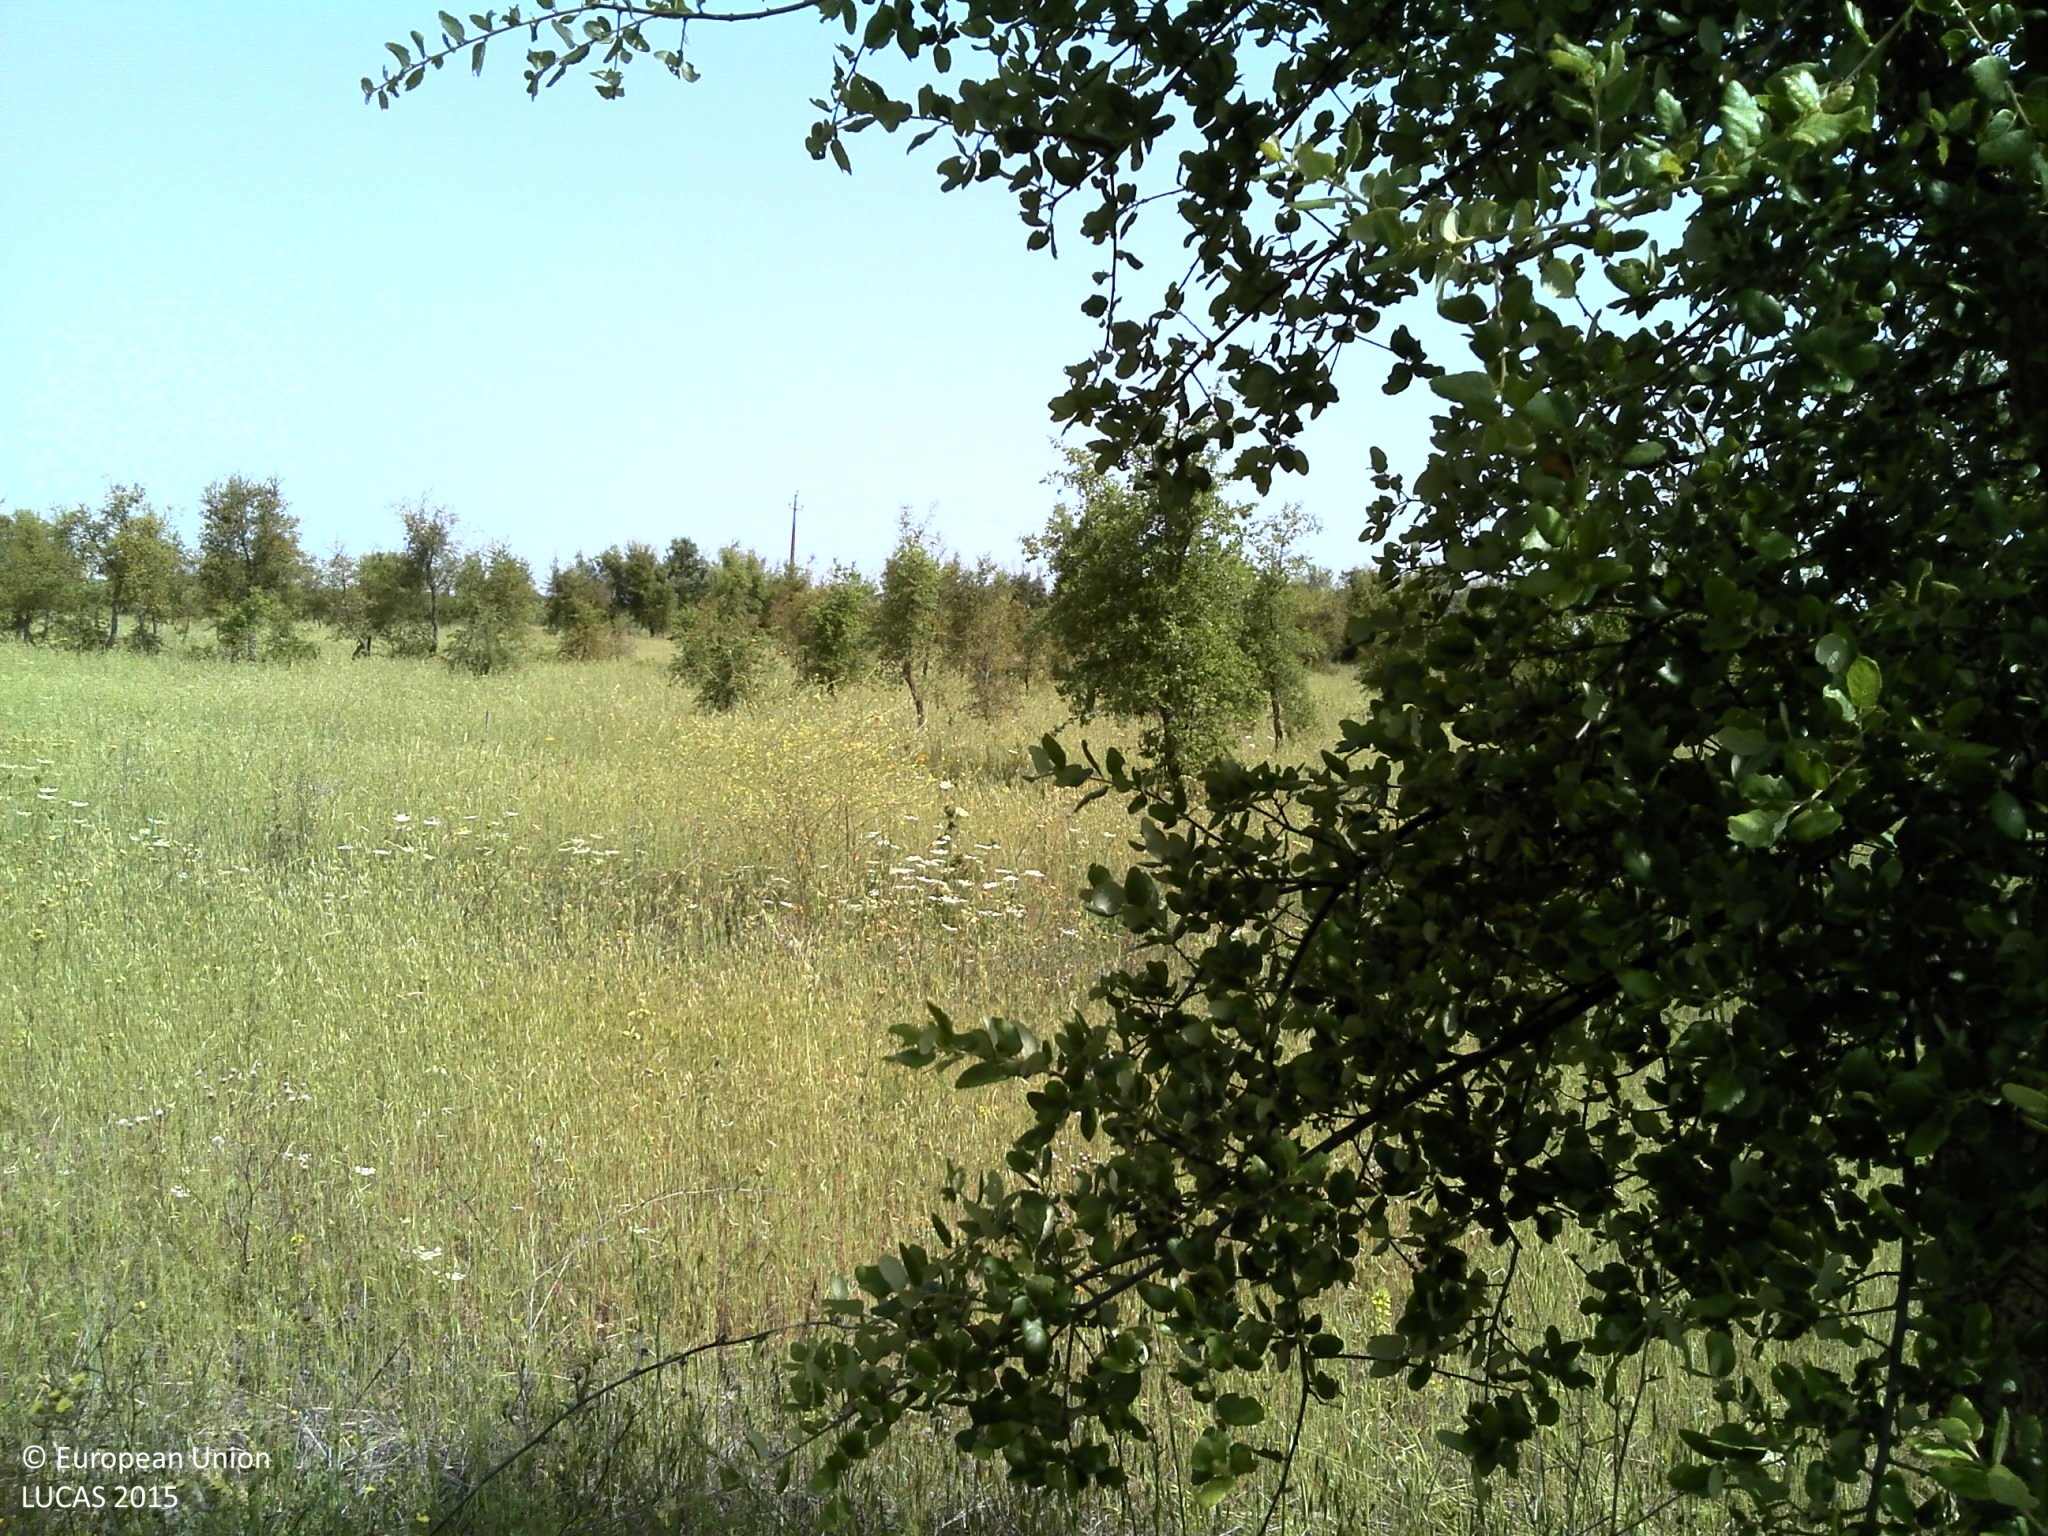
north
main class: Woodland
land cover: Broadleaved woodland
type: broadleaved evergreen forest
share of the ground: 10 - 25 %
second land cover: Grassland without tree/shrub cover
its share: 25 - 50 %
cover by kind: herbaceous plants 40 %, unconsolidated bare surface 40 %, broadleaved forest trees 20 %
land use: Forestry
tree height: < 5 m
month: May
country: PT
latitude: 38.9566
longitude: -7.8038
